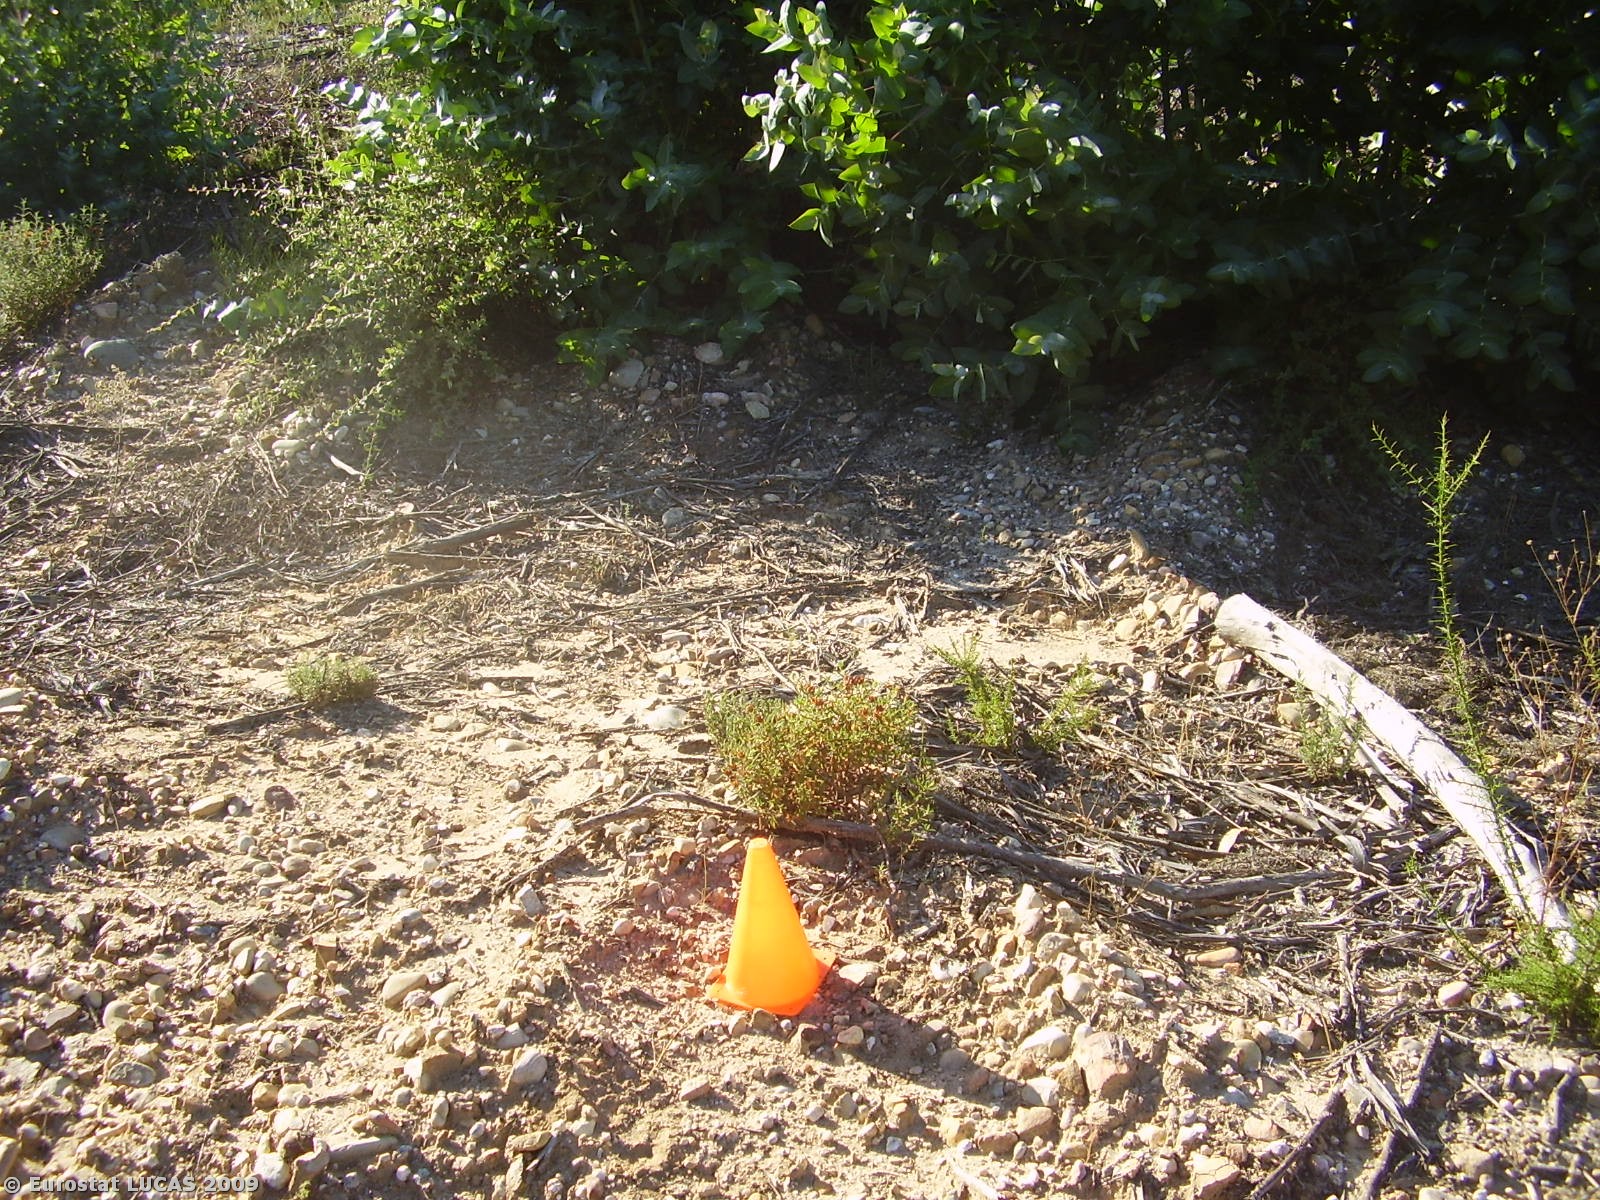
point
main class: Woodland
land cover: Broadleaved woodland
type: plantations and self-sown exotic forest
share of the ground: 50 - 75 %
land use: Forestry
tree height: > 5 m
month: July
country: PT
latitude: 39.3924
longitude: -8.1393
